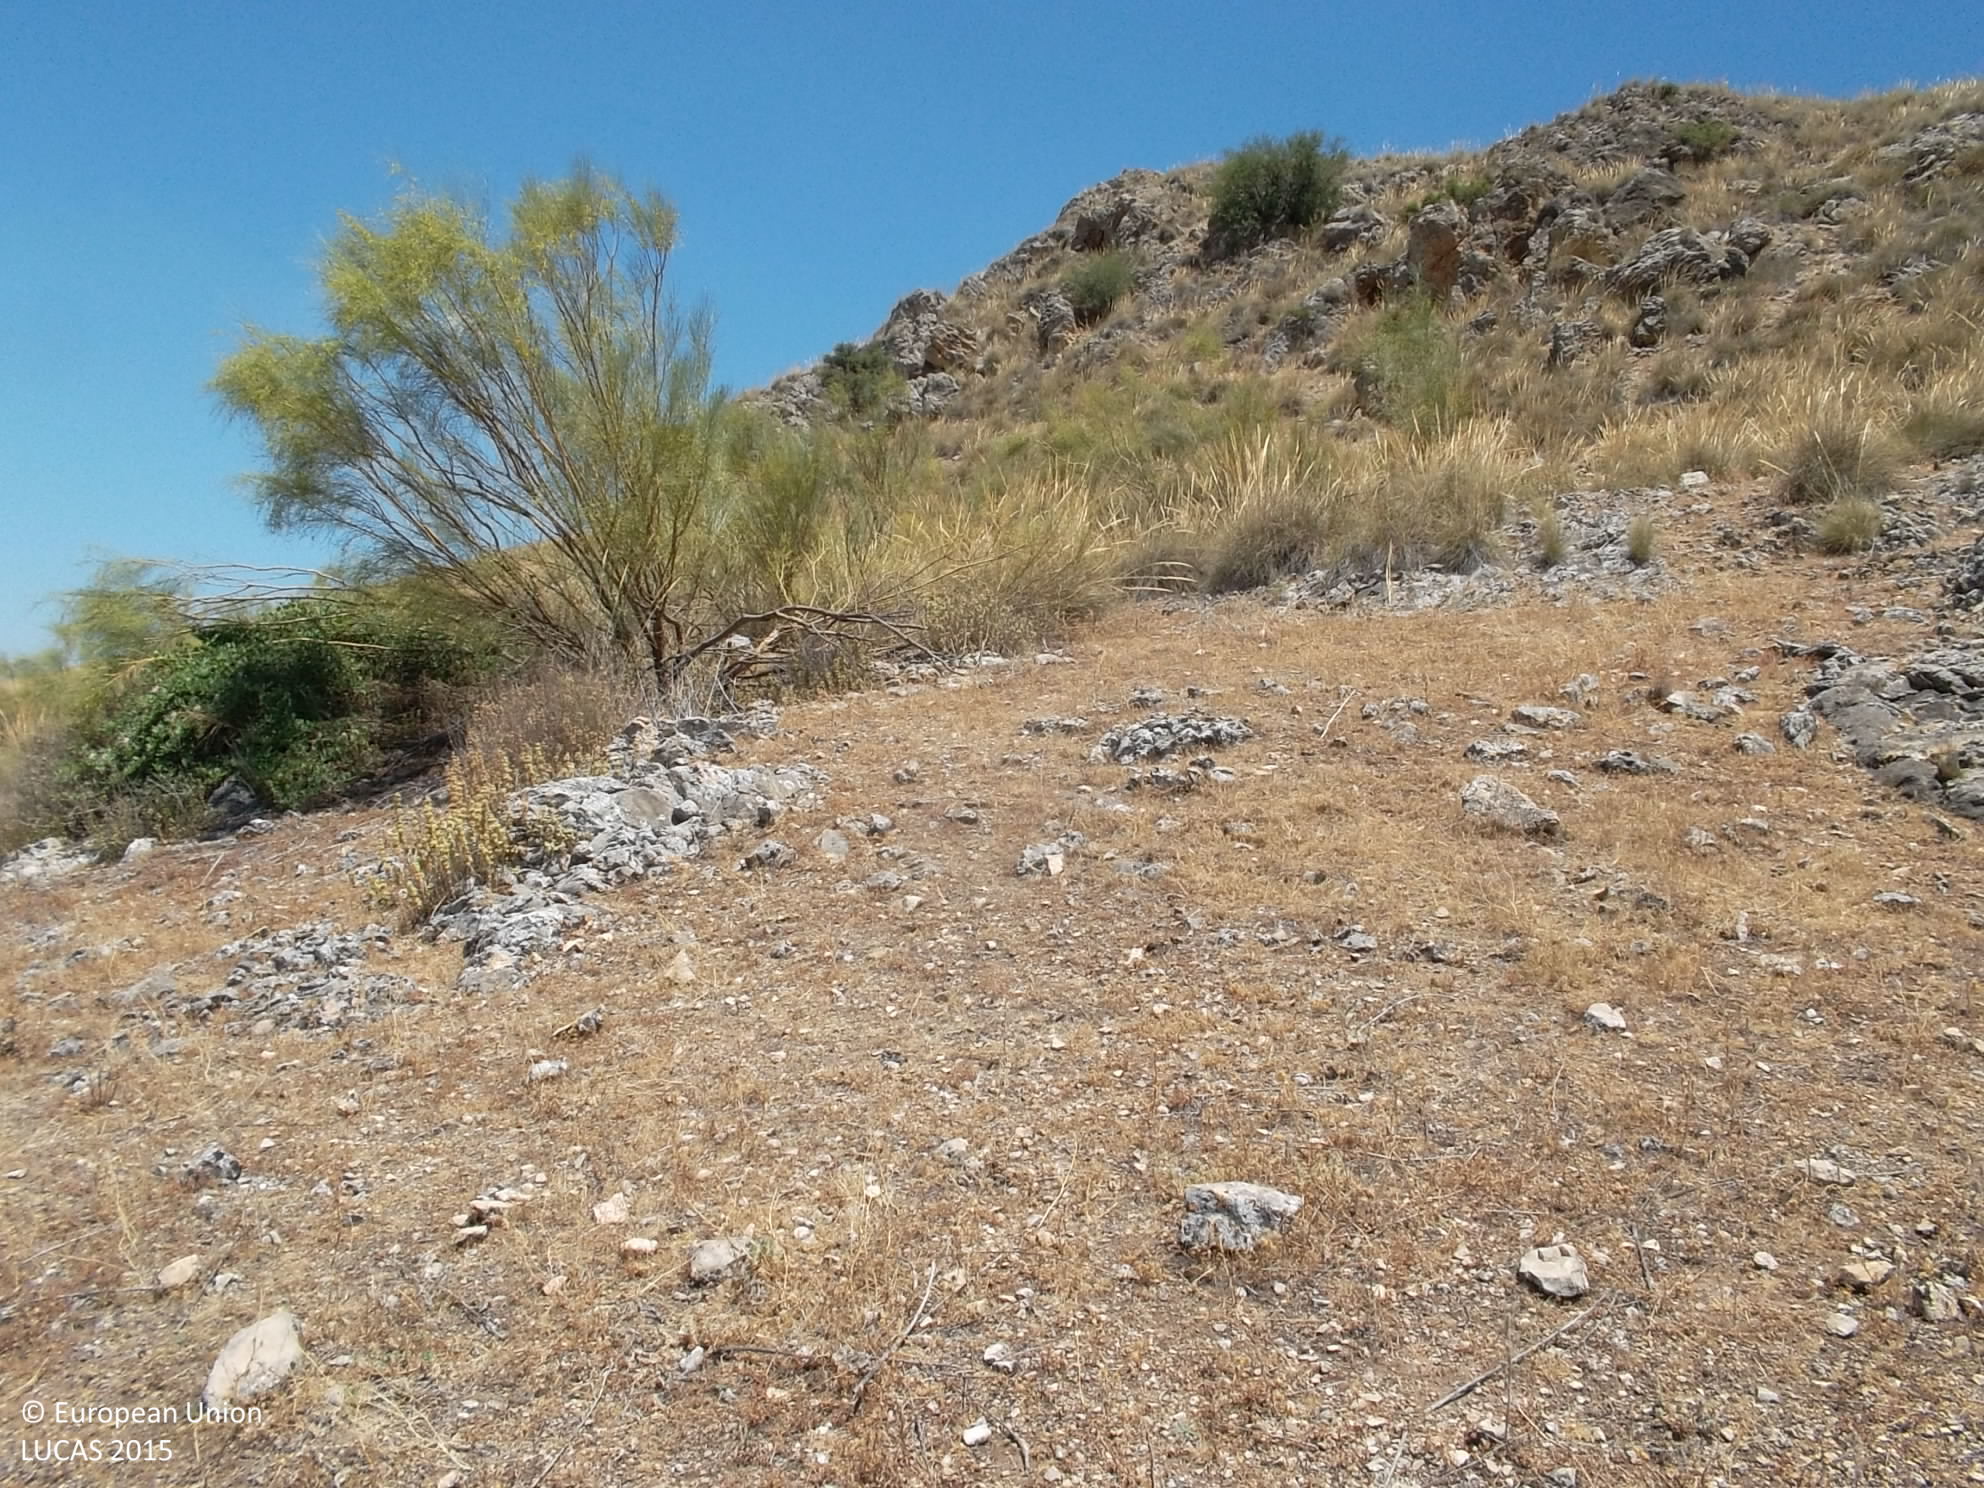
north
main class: Grassland
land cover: Grassland without tree/shrub cover
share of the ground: > 75 %
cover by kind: herbaceous plants 75 %, consolidated bare surface 20 %, shrubs 5 %
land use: Semi-natural and natural areas not in use
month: June
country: ES
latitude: 37.8947
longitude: -3.4058
